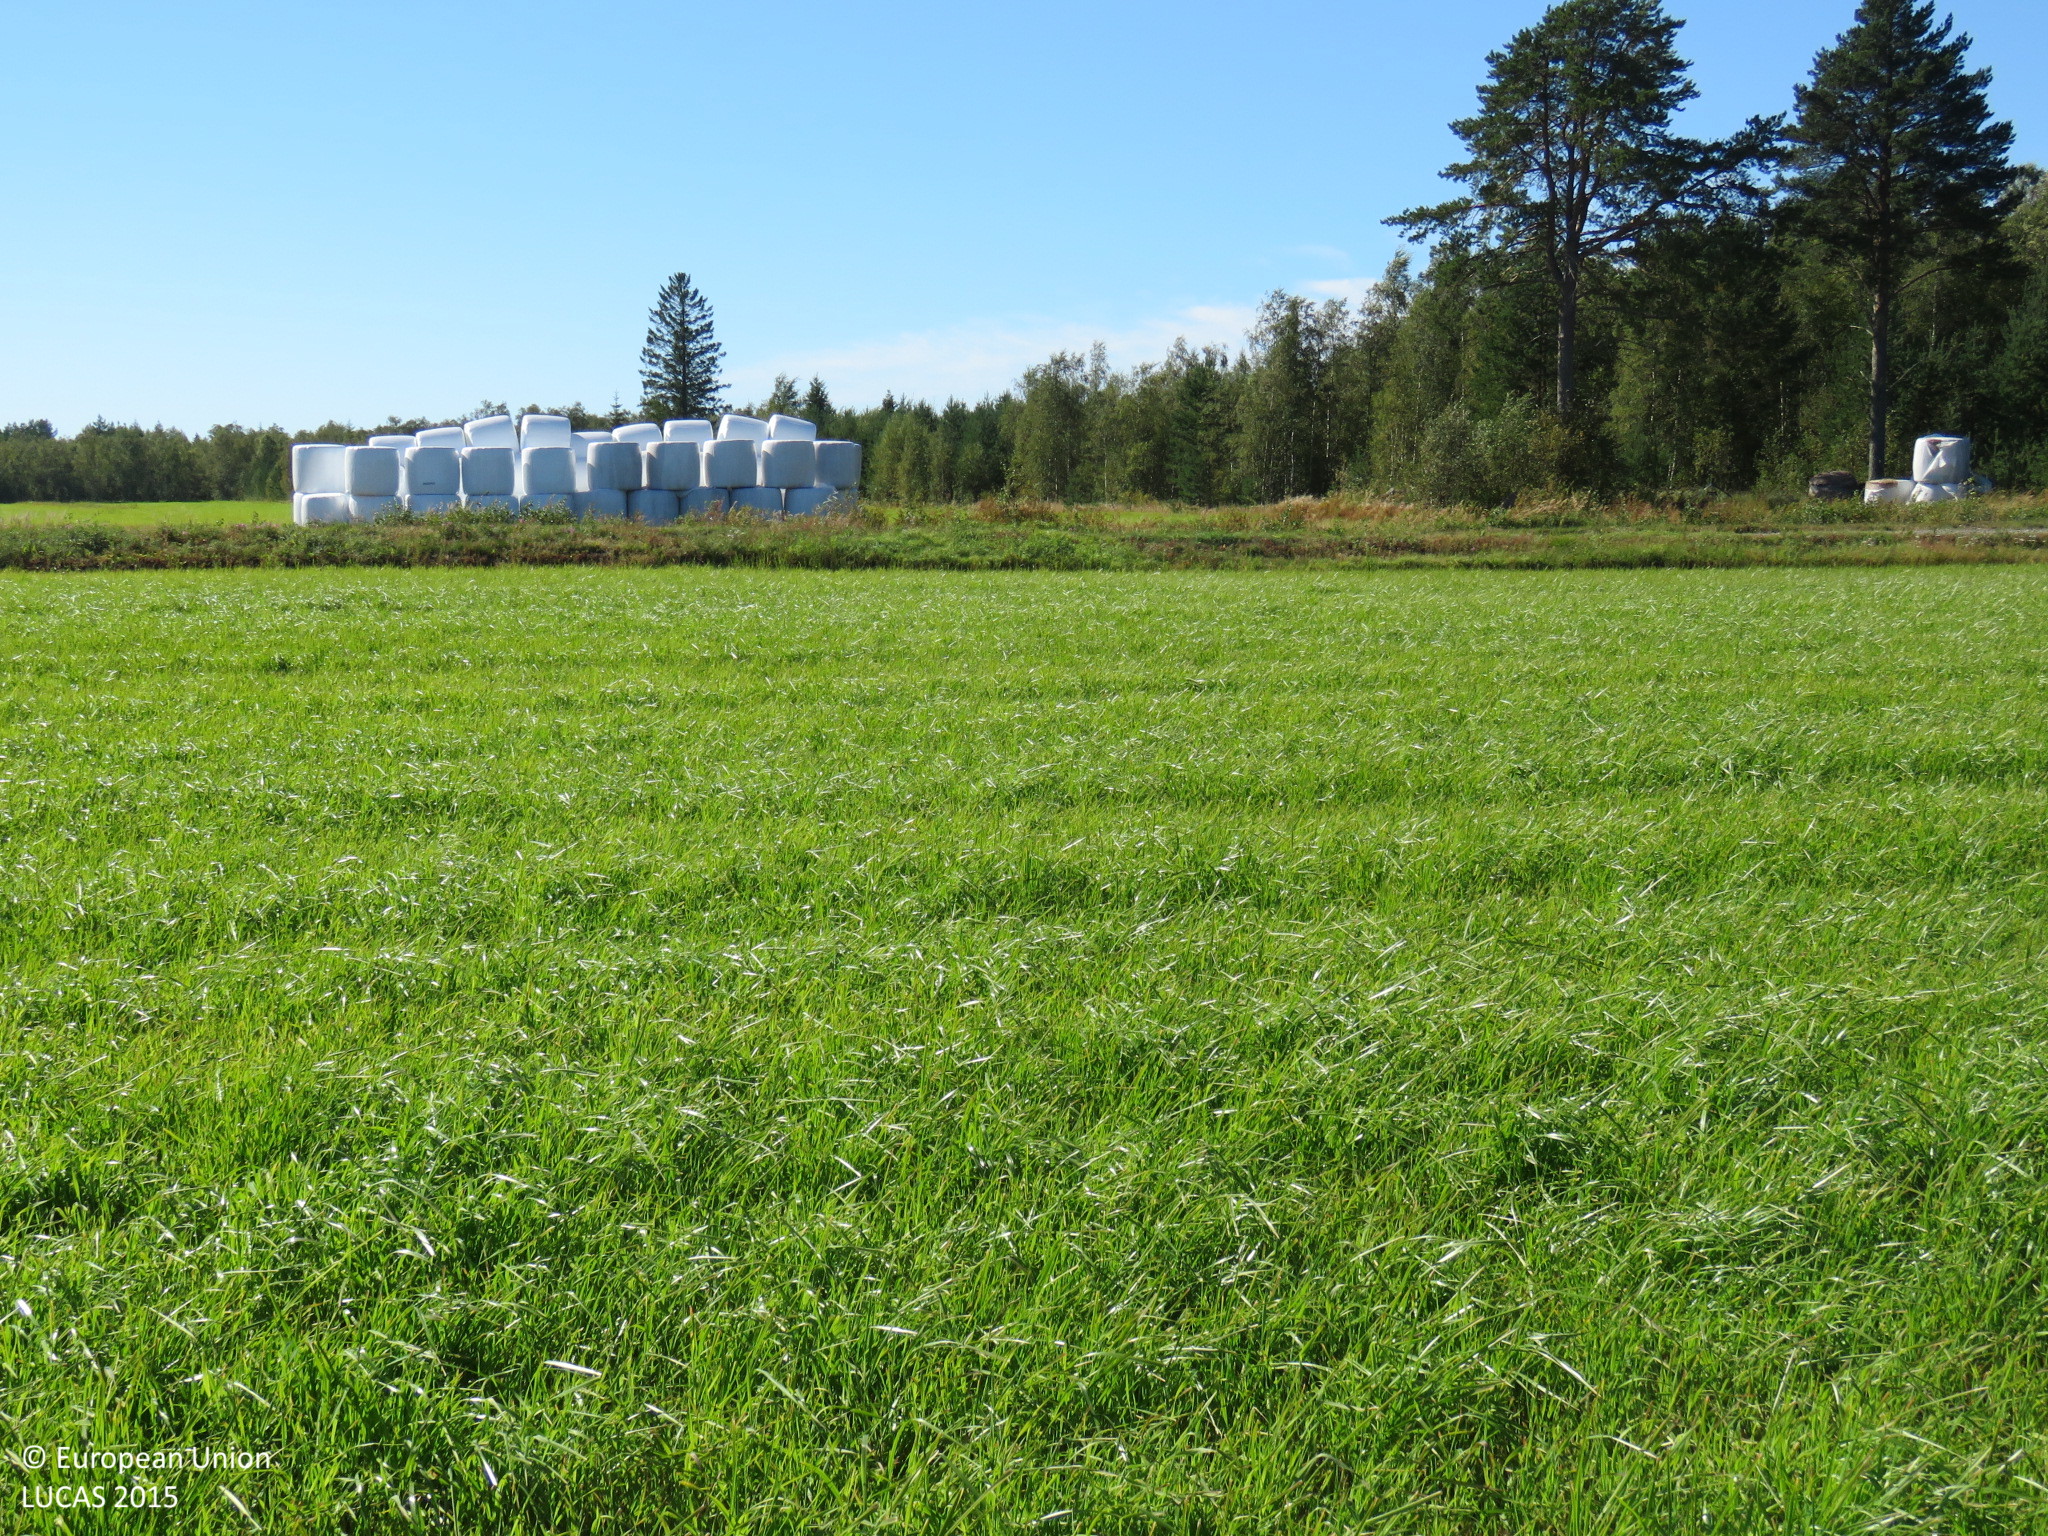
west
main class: Cropland
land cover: Temporary grasslands
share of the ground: > 75 %
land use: Agriculture (excluding fallow land and kitchen gardens)
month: August
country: FI
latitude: 65.0255
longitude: 24.8219
